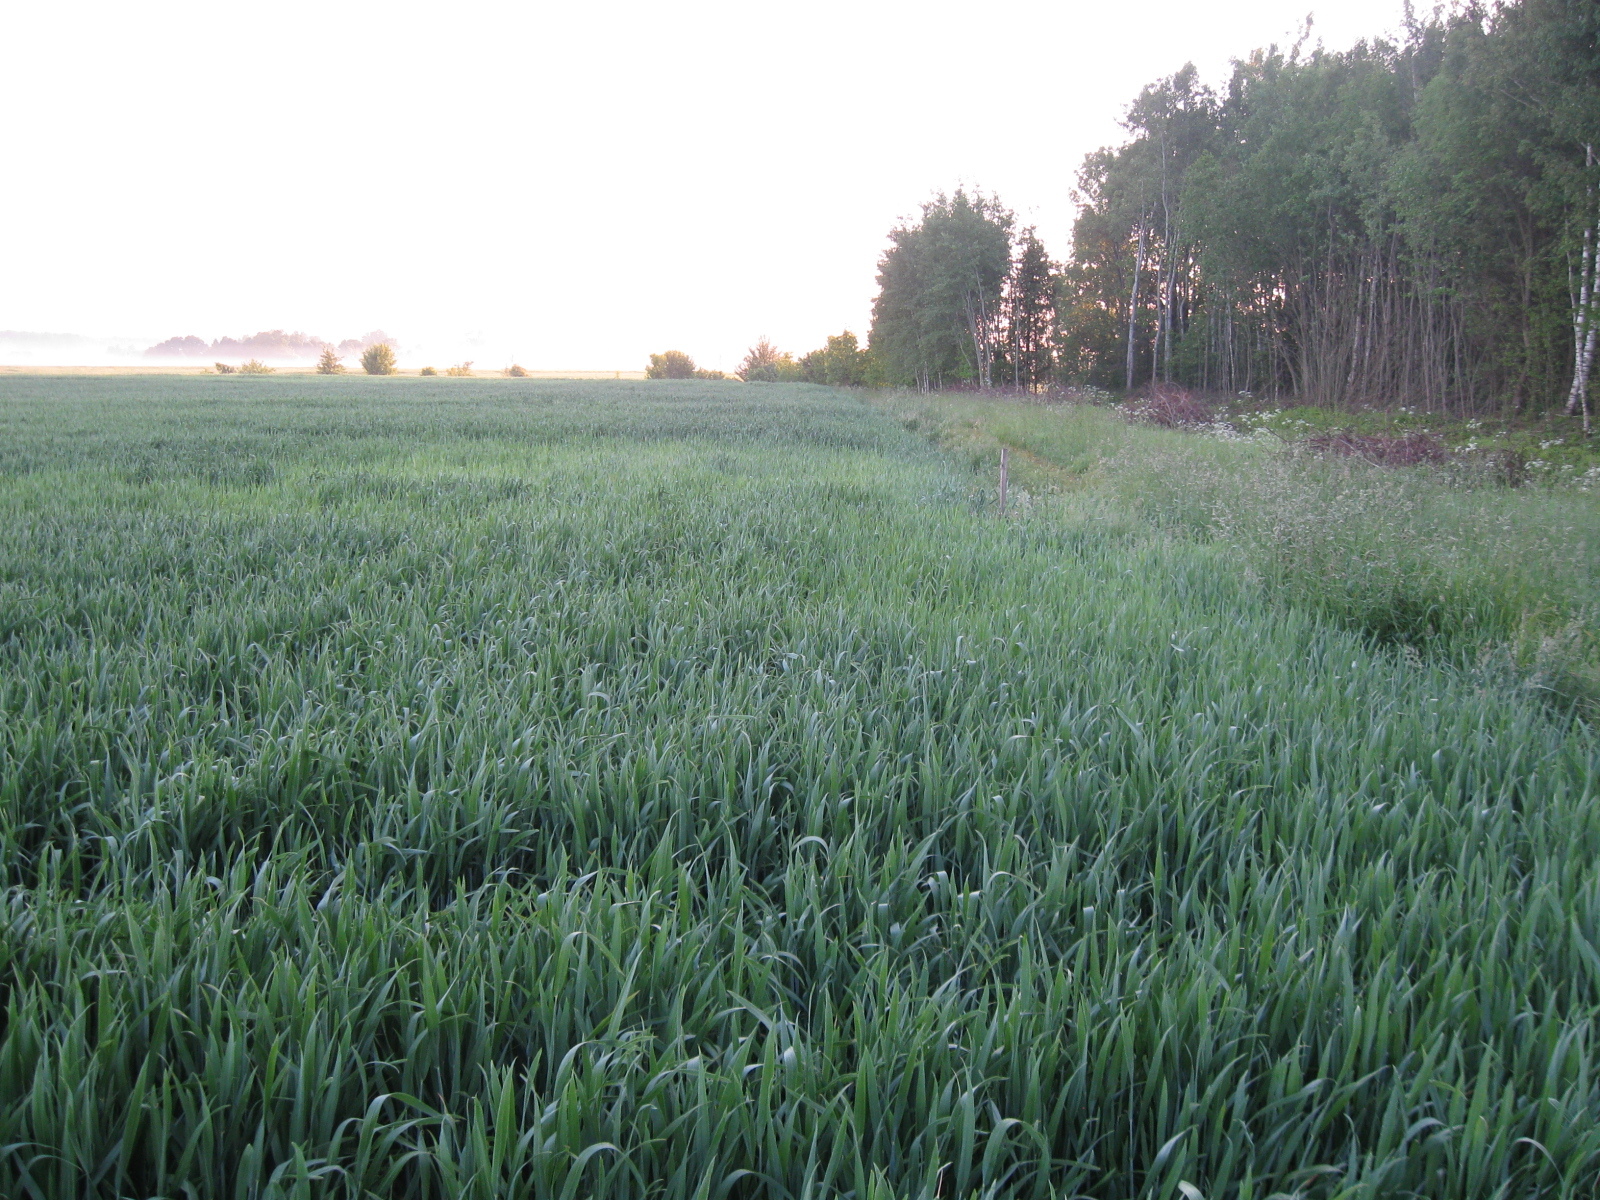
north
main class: Cropland
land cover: Common wheat
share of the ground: > 75 %
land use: Agriculture (excluding fallow land and kitchen gardens)
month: June
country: LT
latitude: 54.4685
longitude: 23.8049
